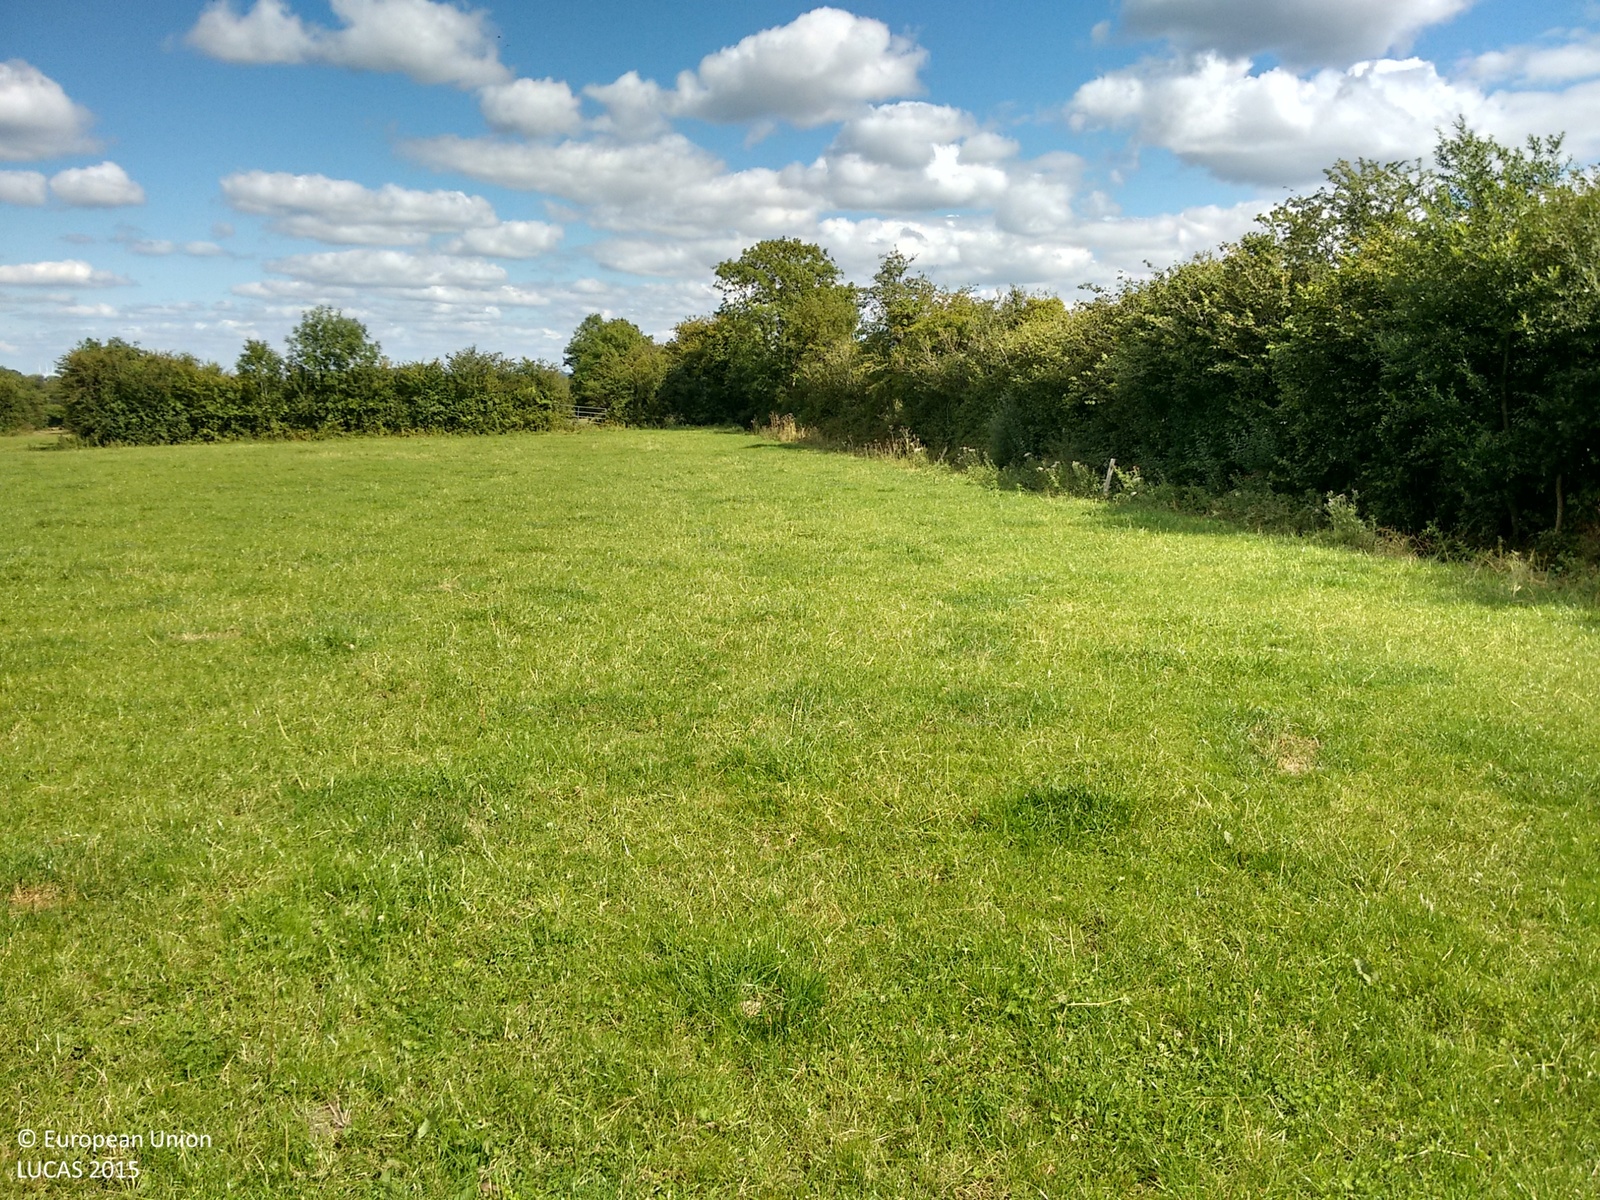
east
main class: Grassland
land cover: Grassland without tree/shrub cover
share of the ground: > 75 %
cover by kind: herbaceous plants 100 %
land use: Agriculture (excluding fallow land and kitchen gardens)
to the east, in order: Grassland without tree/shrub cover; Abandoned hedges; Ditches and canals; Fences; Grassland with sparse tree/shrub cover; Fences; Grassland without tree/shrub cover
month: August
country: IE
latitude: 52.8906
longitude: -7.8424
